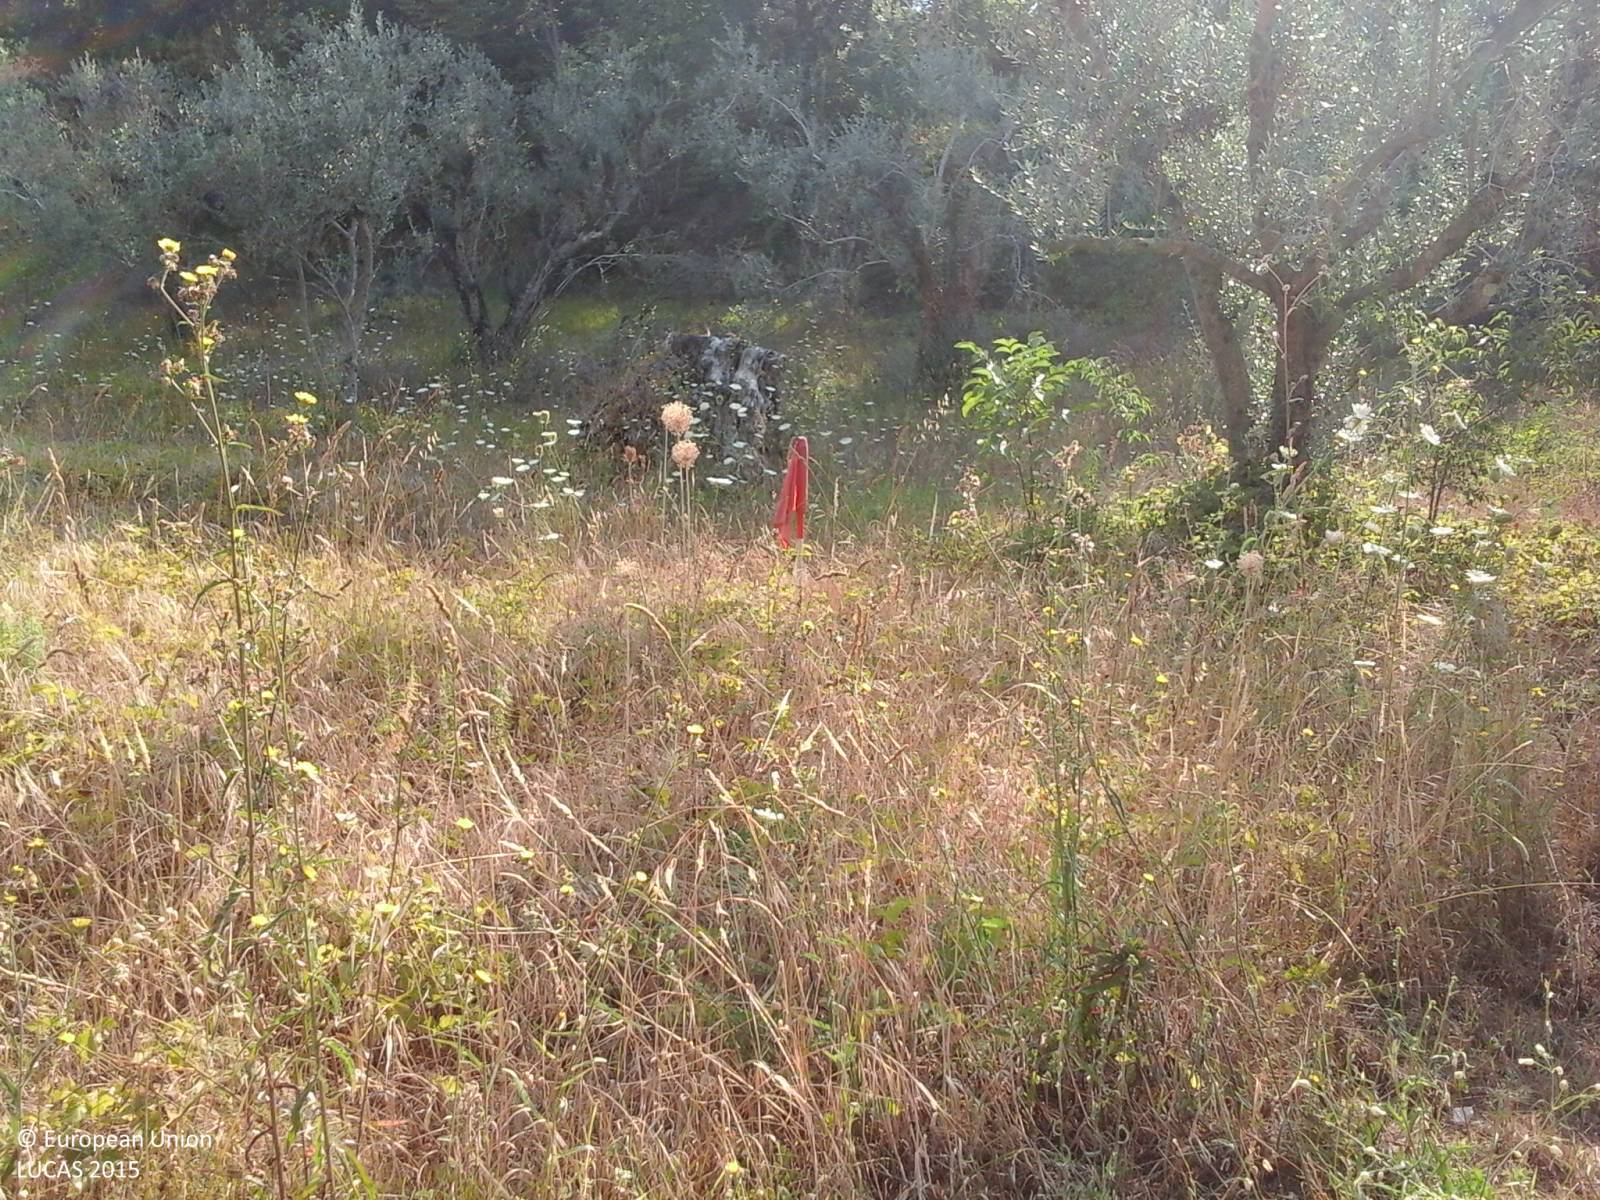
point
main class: Cropland
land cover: Olive groves
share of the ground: 50 - 75 %
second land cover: Spontaneously vegetated surfaces
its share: > 75 %
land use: Agriculture (excluding fallow land and kitchen gardens)
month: August
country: IT
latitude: 41.3516
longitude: 14.2747
